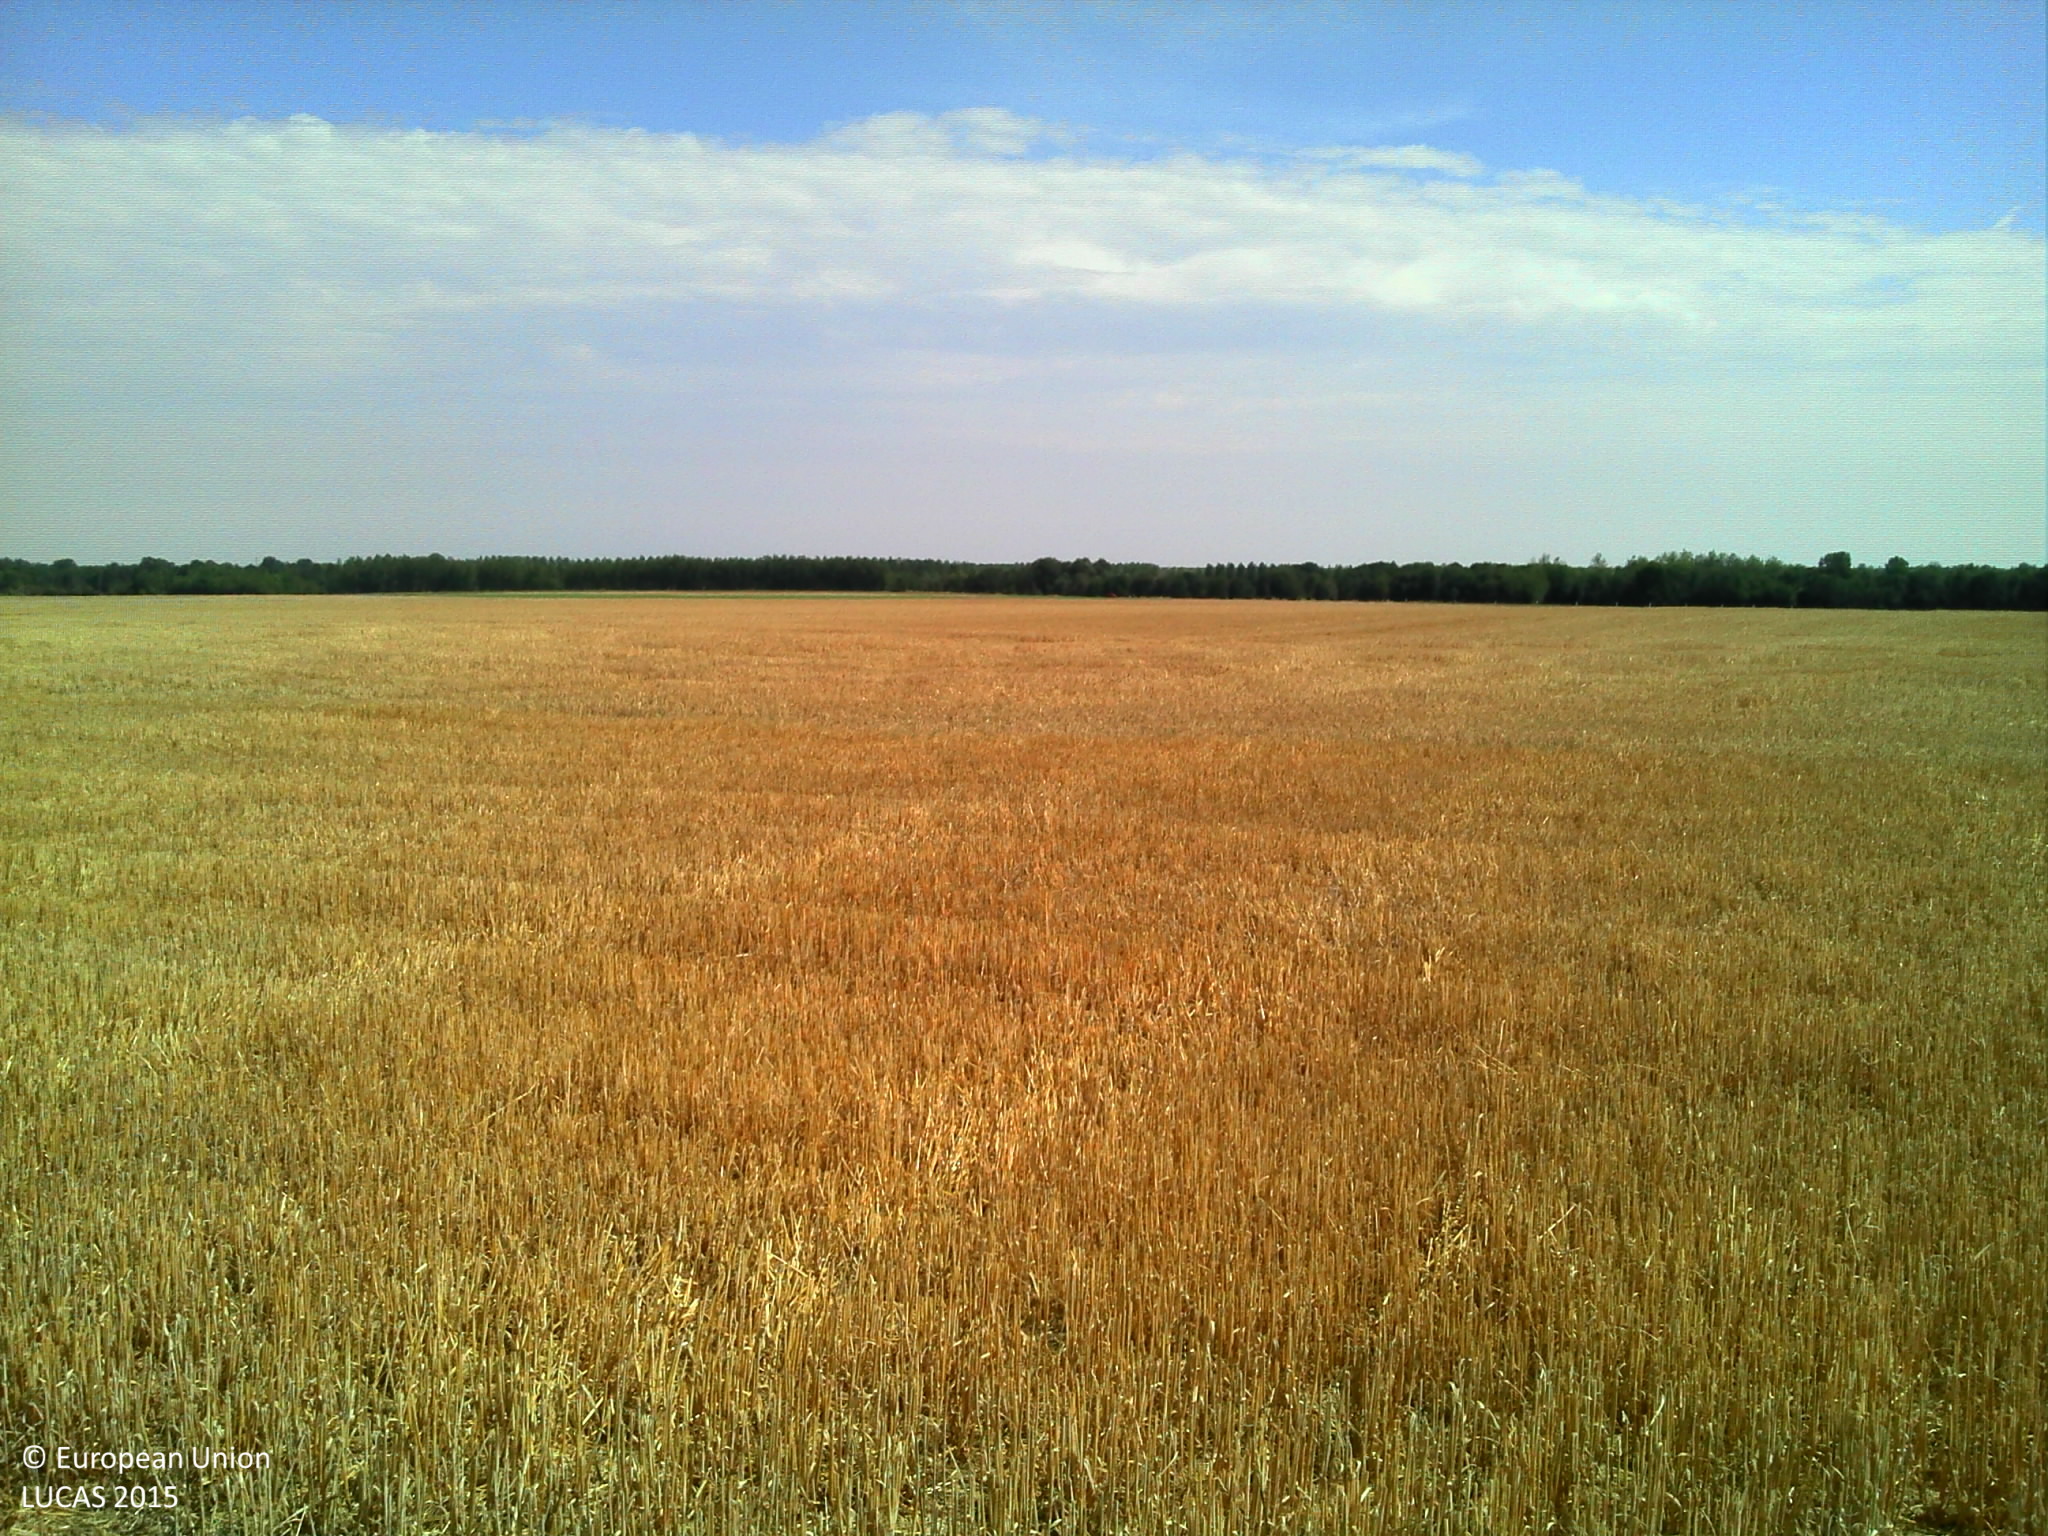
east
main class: Cropland
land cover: Barley
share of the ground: > 75 %
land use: Agriculture (excluding fallow land and kitchen gardens)
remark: Harvested field
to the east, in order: Barley; Common wheat; Dry pulses
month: August
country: FR
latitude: 48.9887
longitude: 4.1604
